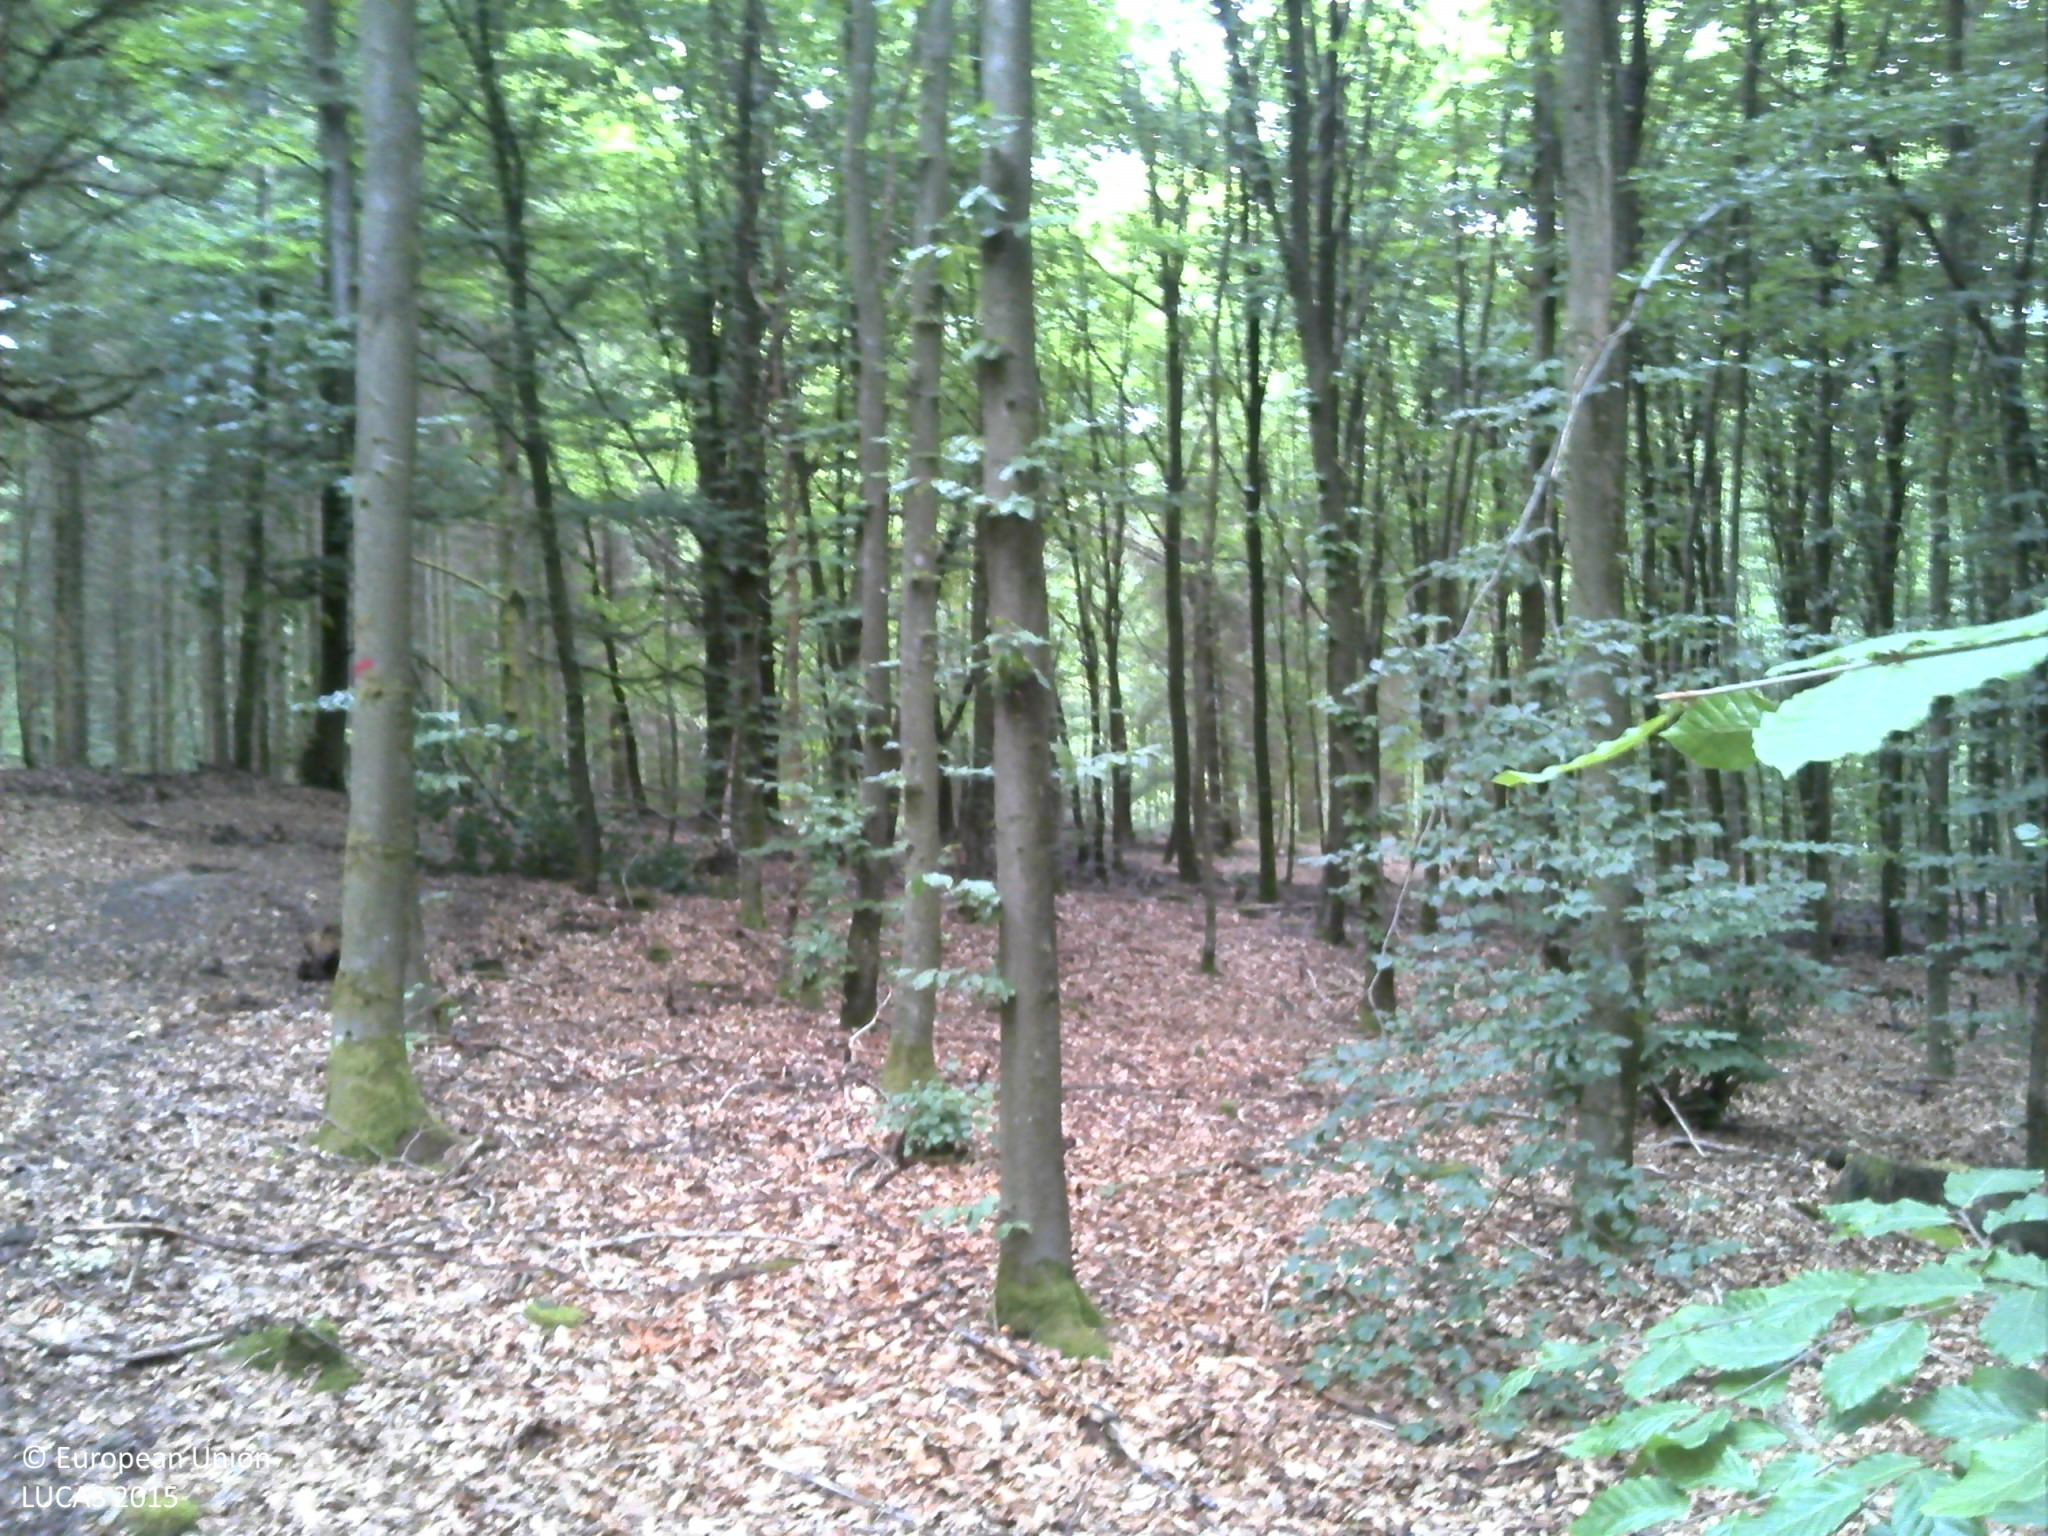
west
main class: Woodland
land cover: Broadleaved woodland
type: beech forest
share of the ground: > 75 %
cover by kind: broadleaved forest trees 70 %, consolidated bare surface 30 %
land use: Forestry
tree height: > 5 m
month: July
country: FR
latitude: 49.8268
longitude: 4.7003
